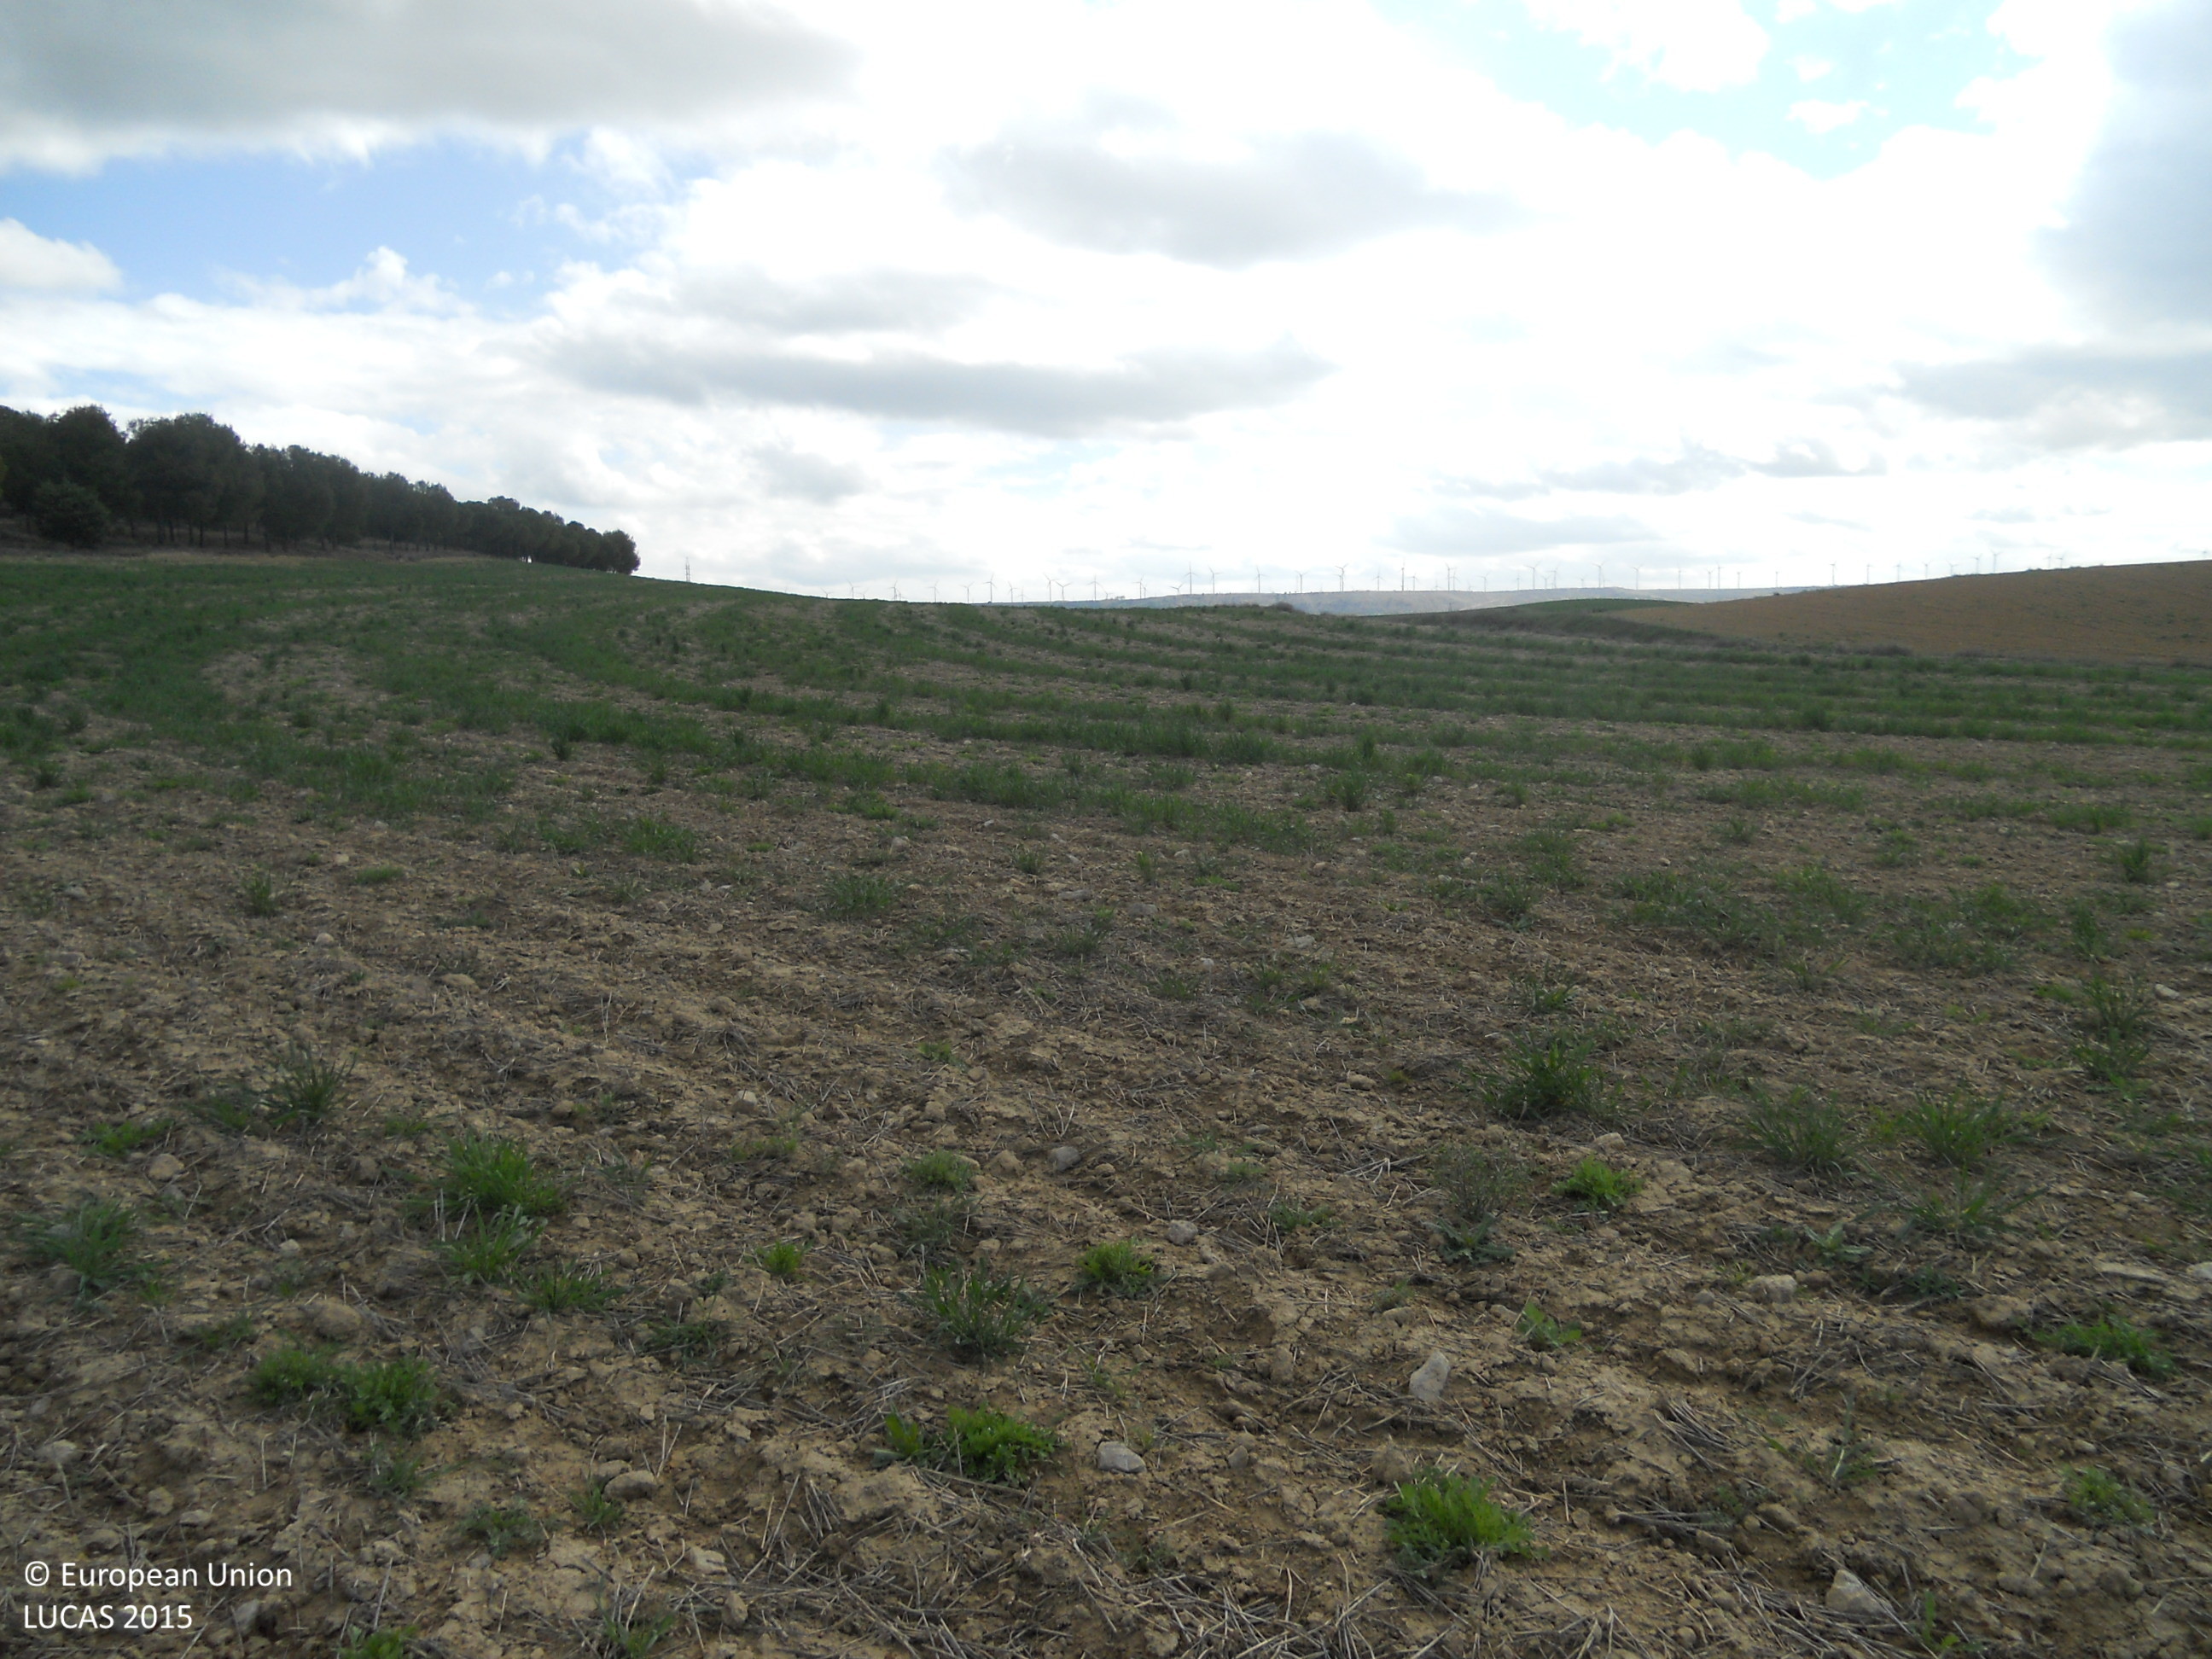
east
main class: Grassland
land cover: Spontaneously vegetated surfaces
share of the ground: 10 - 25 %
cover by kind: herbaceous plants 100 %
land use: Fallow land
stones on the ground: < 10 %
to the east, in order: Spontaneously vegetated surfaces
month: April
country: ES
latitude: 42.2046
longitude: -4.2751
